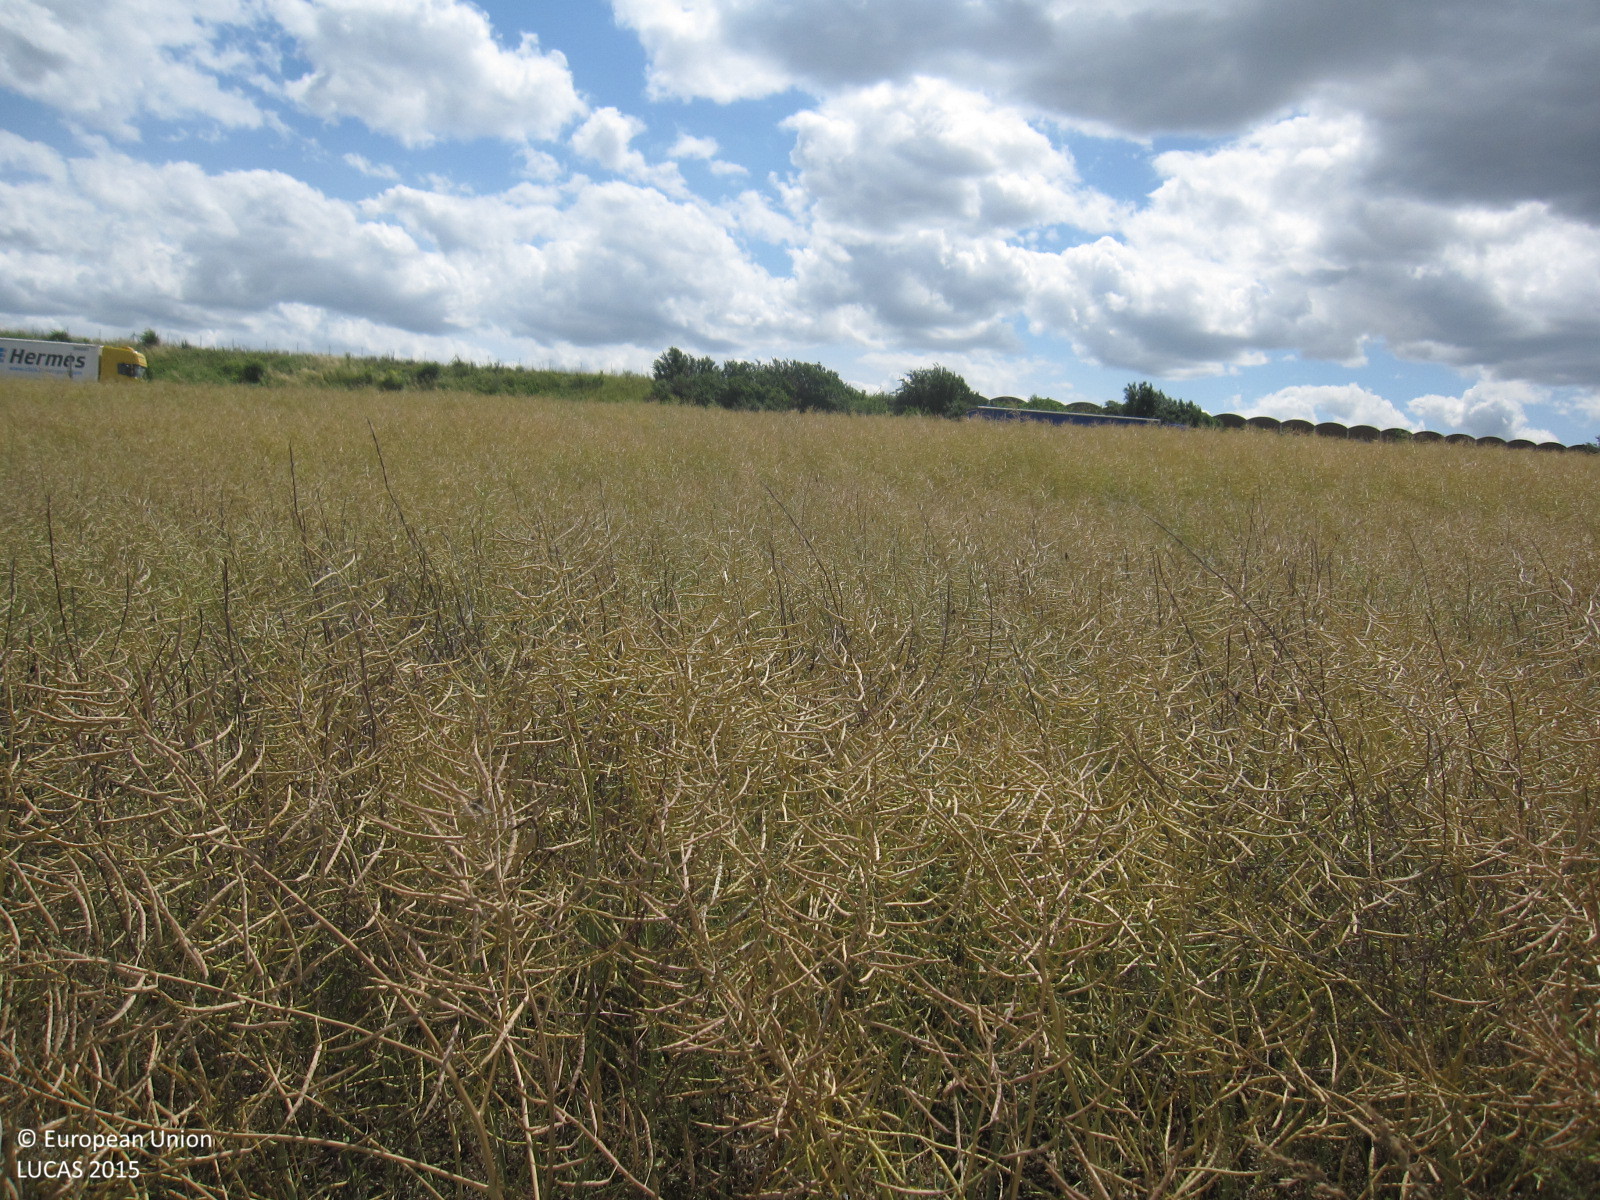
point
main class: Cropland
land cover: Rape and turnip rape
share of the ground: > 75 %
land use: Agriculture (excluding fallow land and kitchen gardens)
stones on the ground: < 10 %
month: July
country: DE
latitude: 50.9040
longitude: 12.0047
